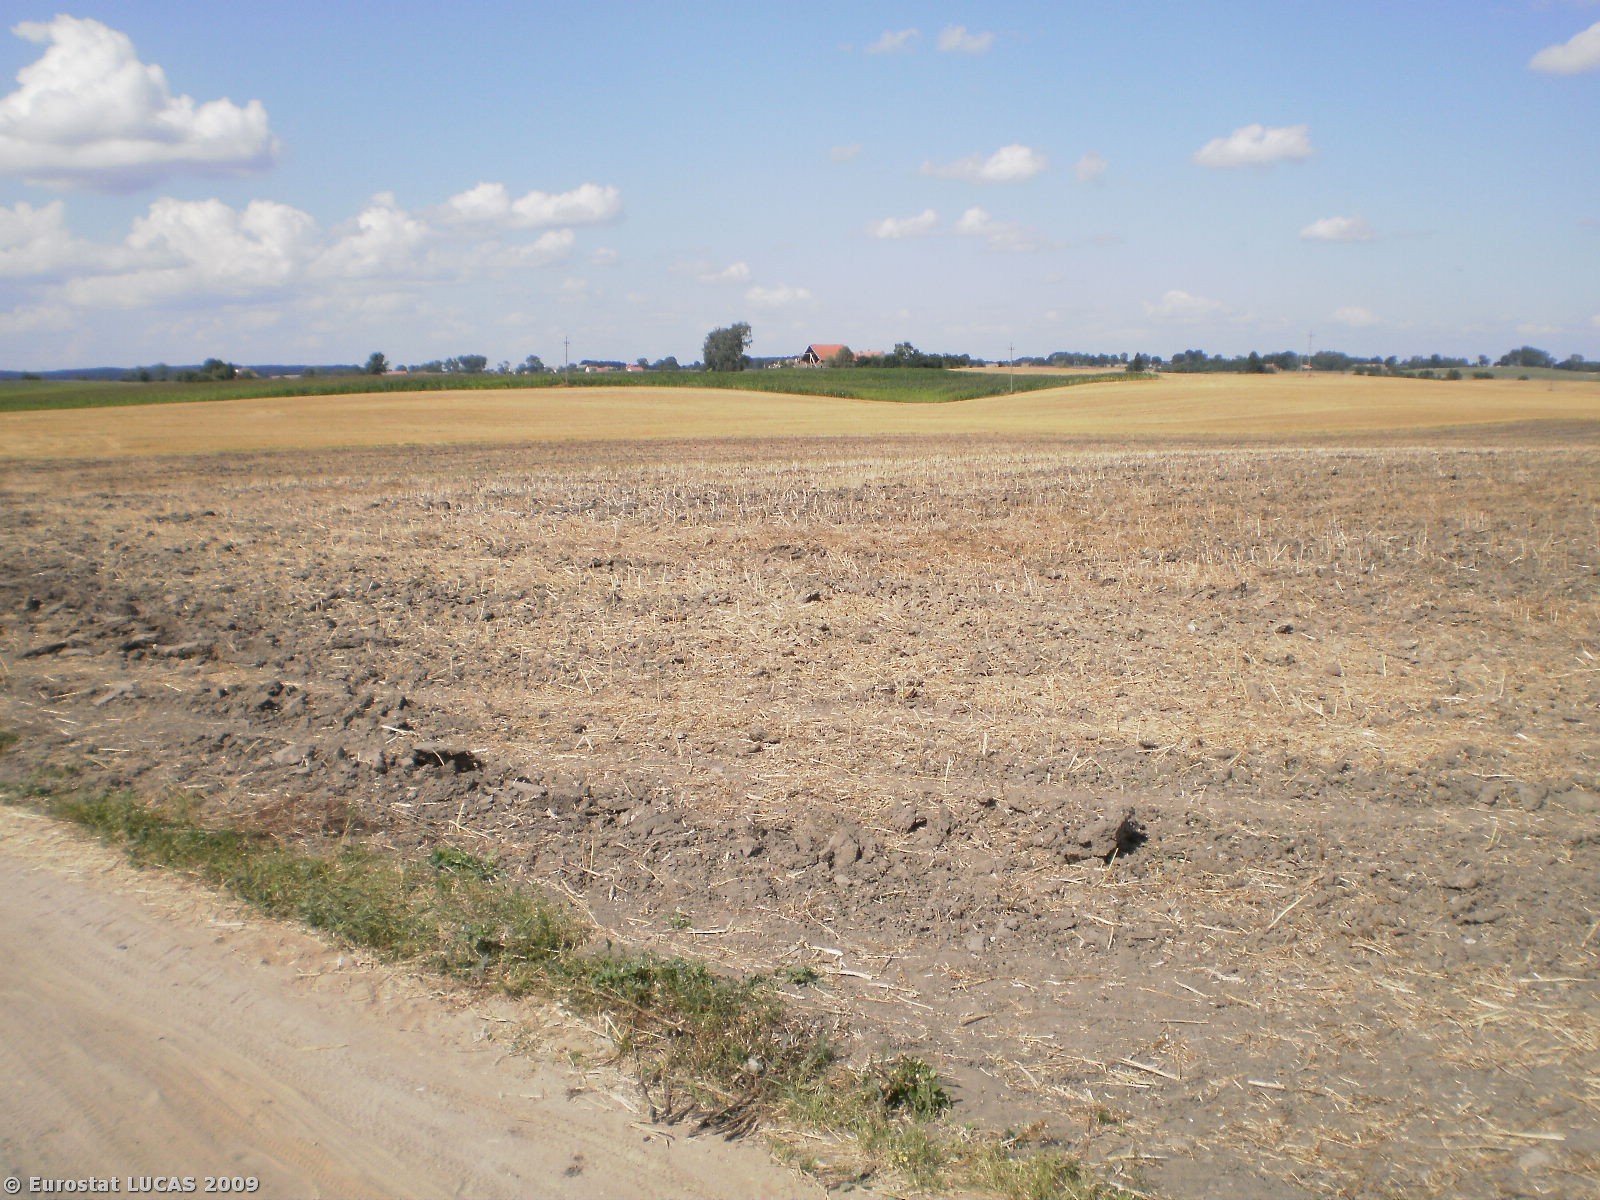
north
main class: Grassland
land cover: Spontaneously vegetated surfaces
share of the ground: > 75 %
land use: Fallow land
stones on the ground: < 10 %
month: August
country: PL
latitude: 54.0447
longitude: 21.1782
